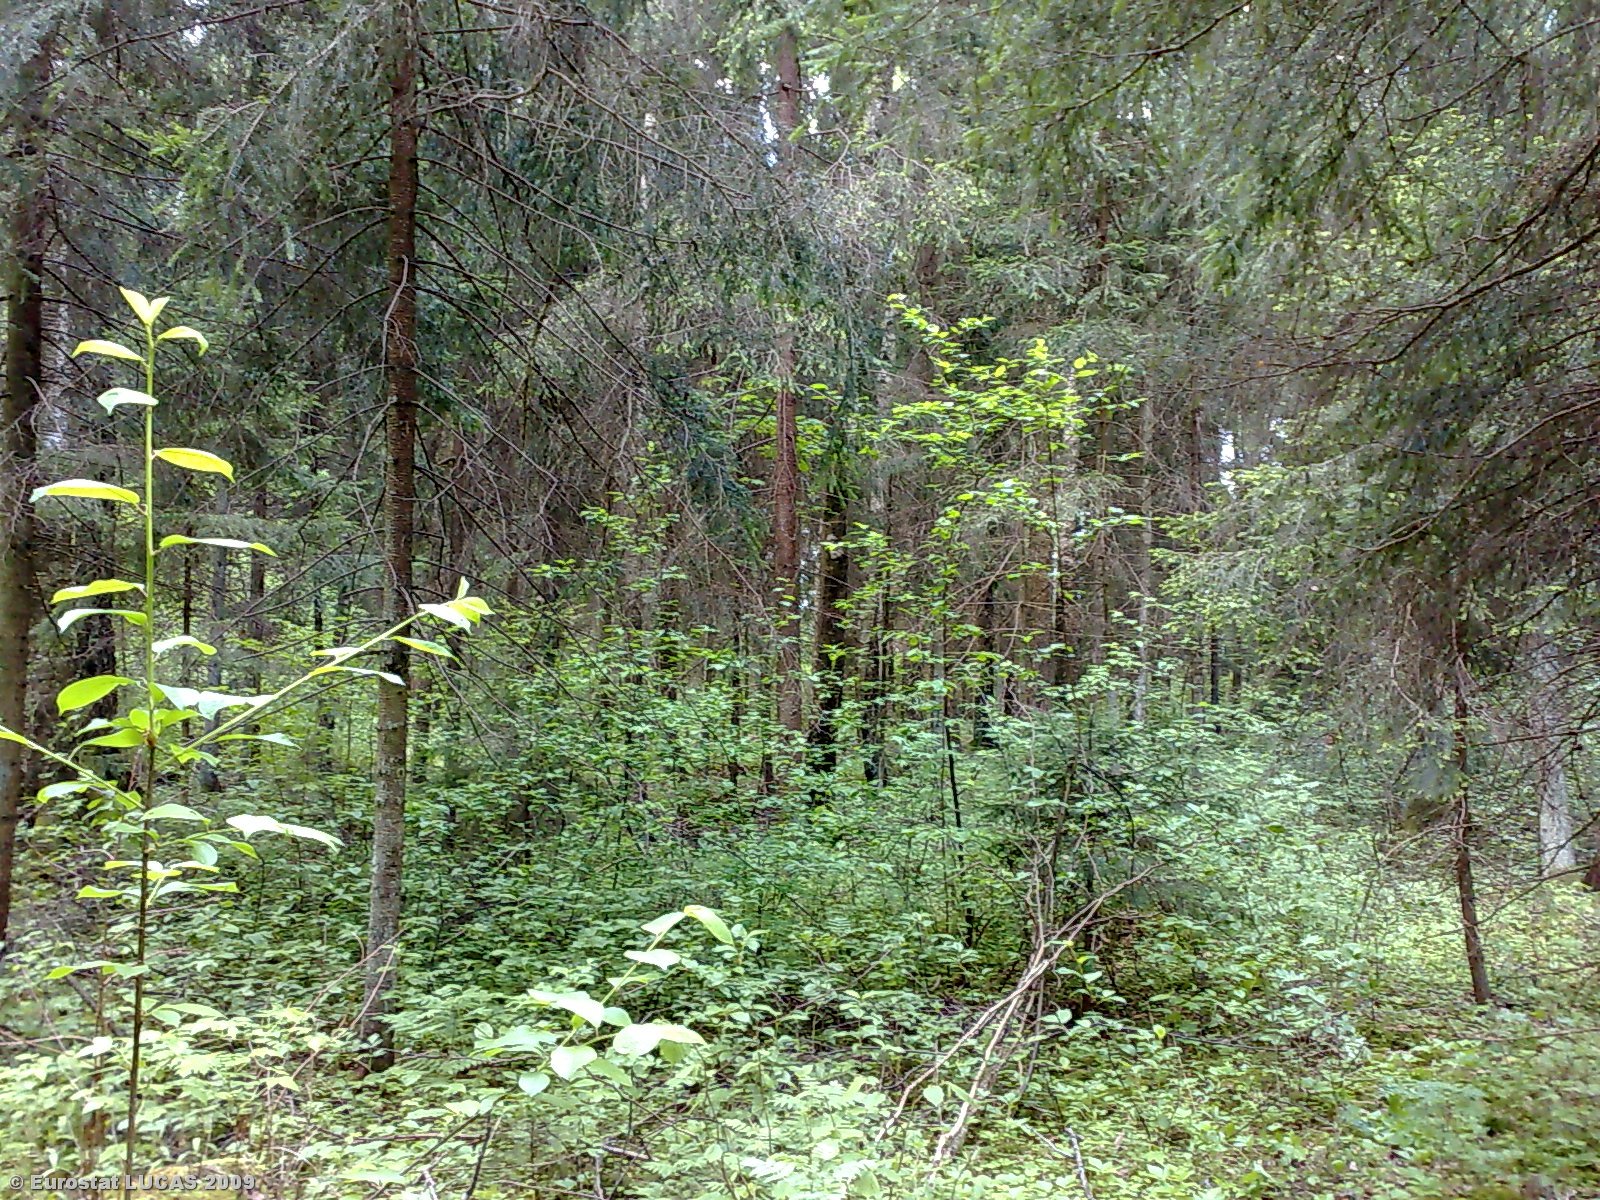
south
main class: Woodland
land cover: Mixed woodland
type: hemiboreal forest and nemoral coniferous forest and mixed broadleaved-coniferous forest
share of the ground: > 75 %
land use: Forestry
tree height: > 5 m
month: May
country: LT
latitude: 55.5968
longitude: 23.8446
